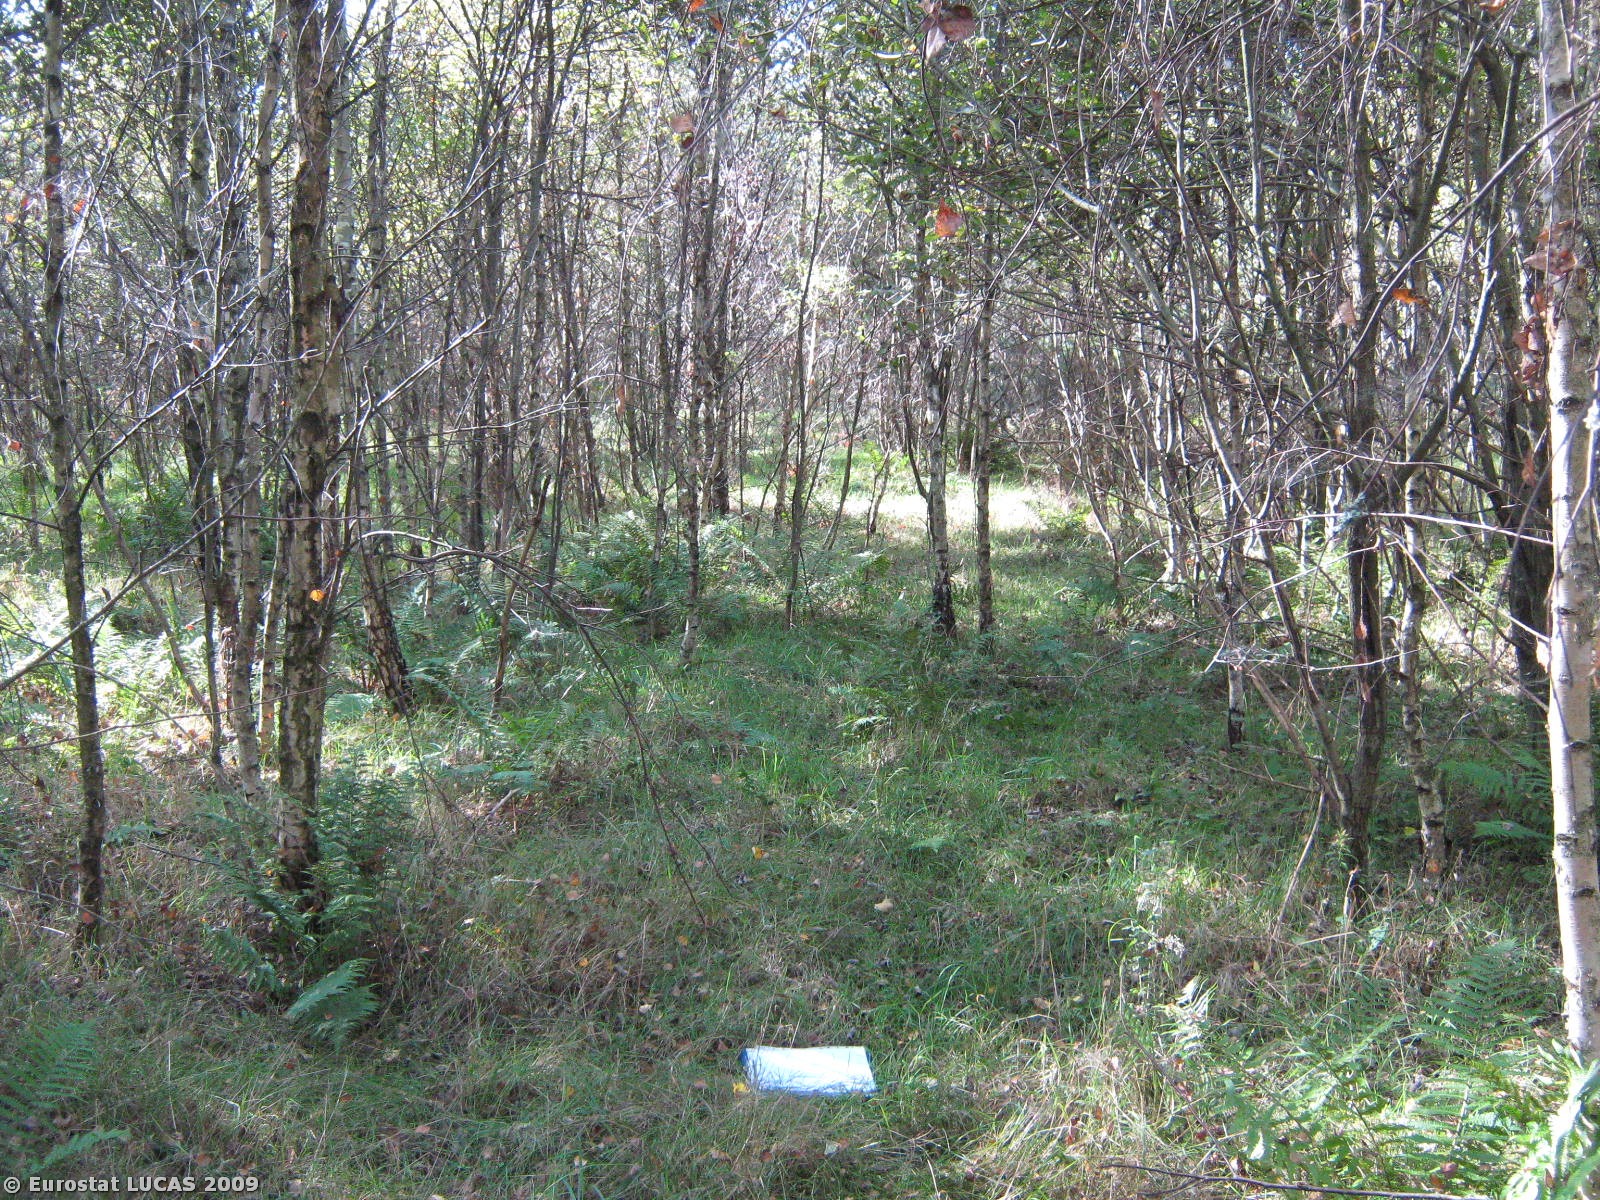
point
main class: Woodland
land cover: Broadleaved woodland
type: hemiboreal forest and nemoral coniferous forest and mixed broadleaved-coniferous forest
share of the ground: > 75 %
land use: Forestry
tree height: > 5 m
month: September
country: PL
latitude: 53.9903
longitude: 16.3965
